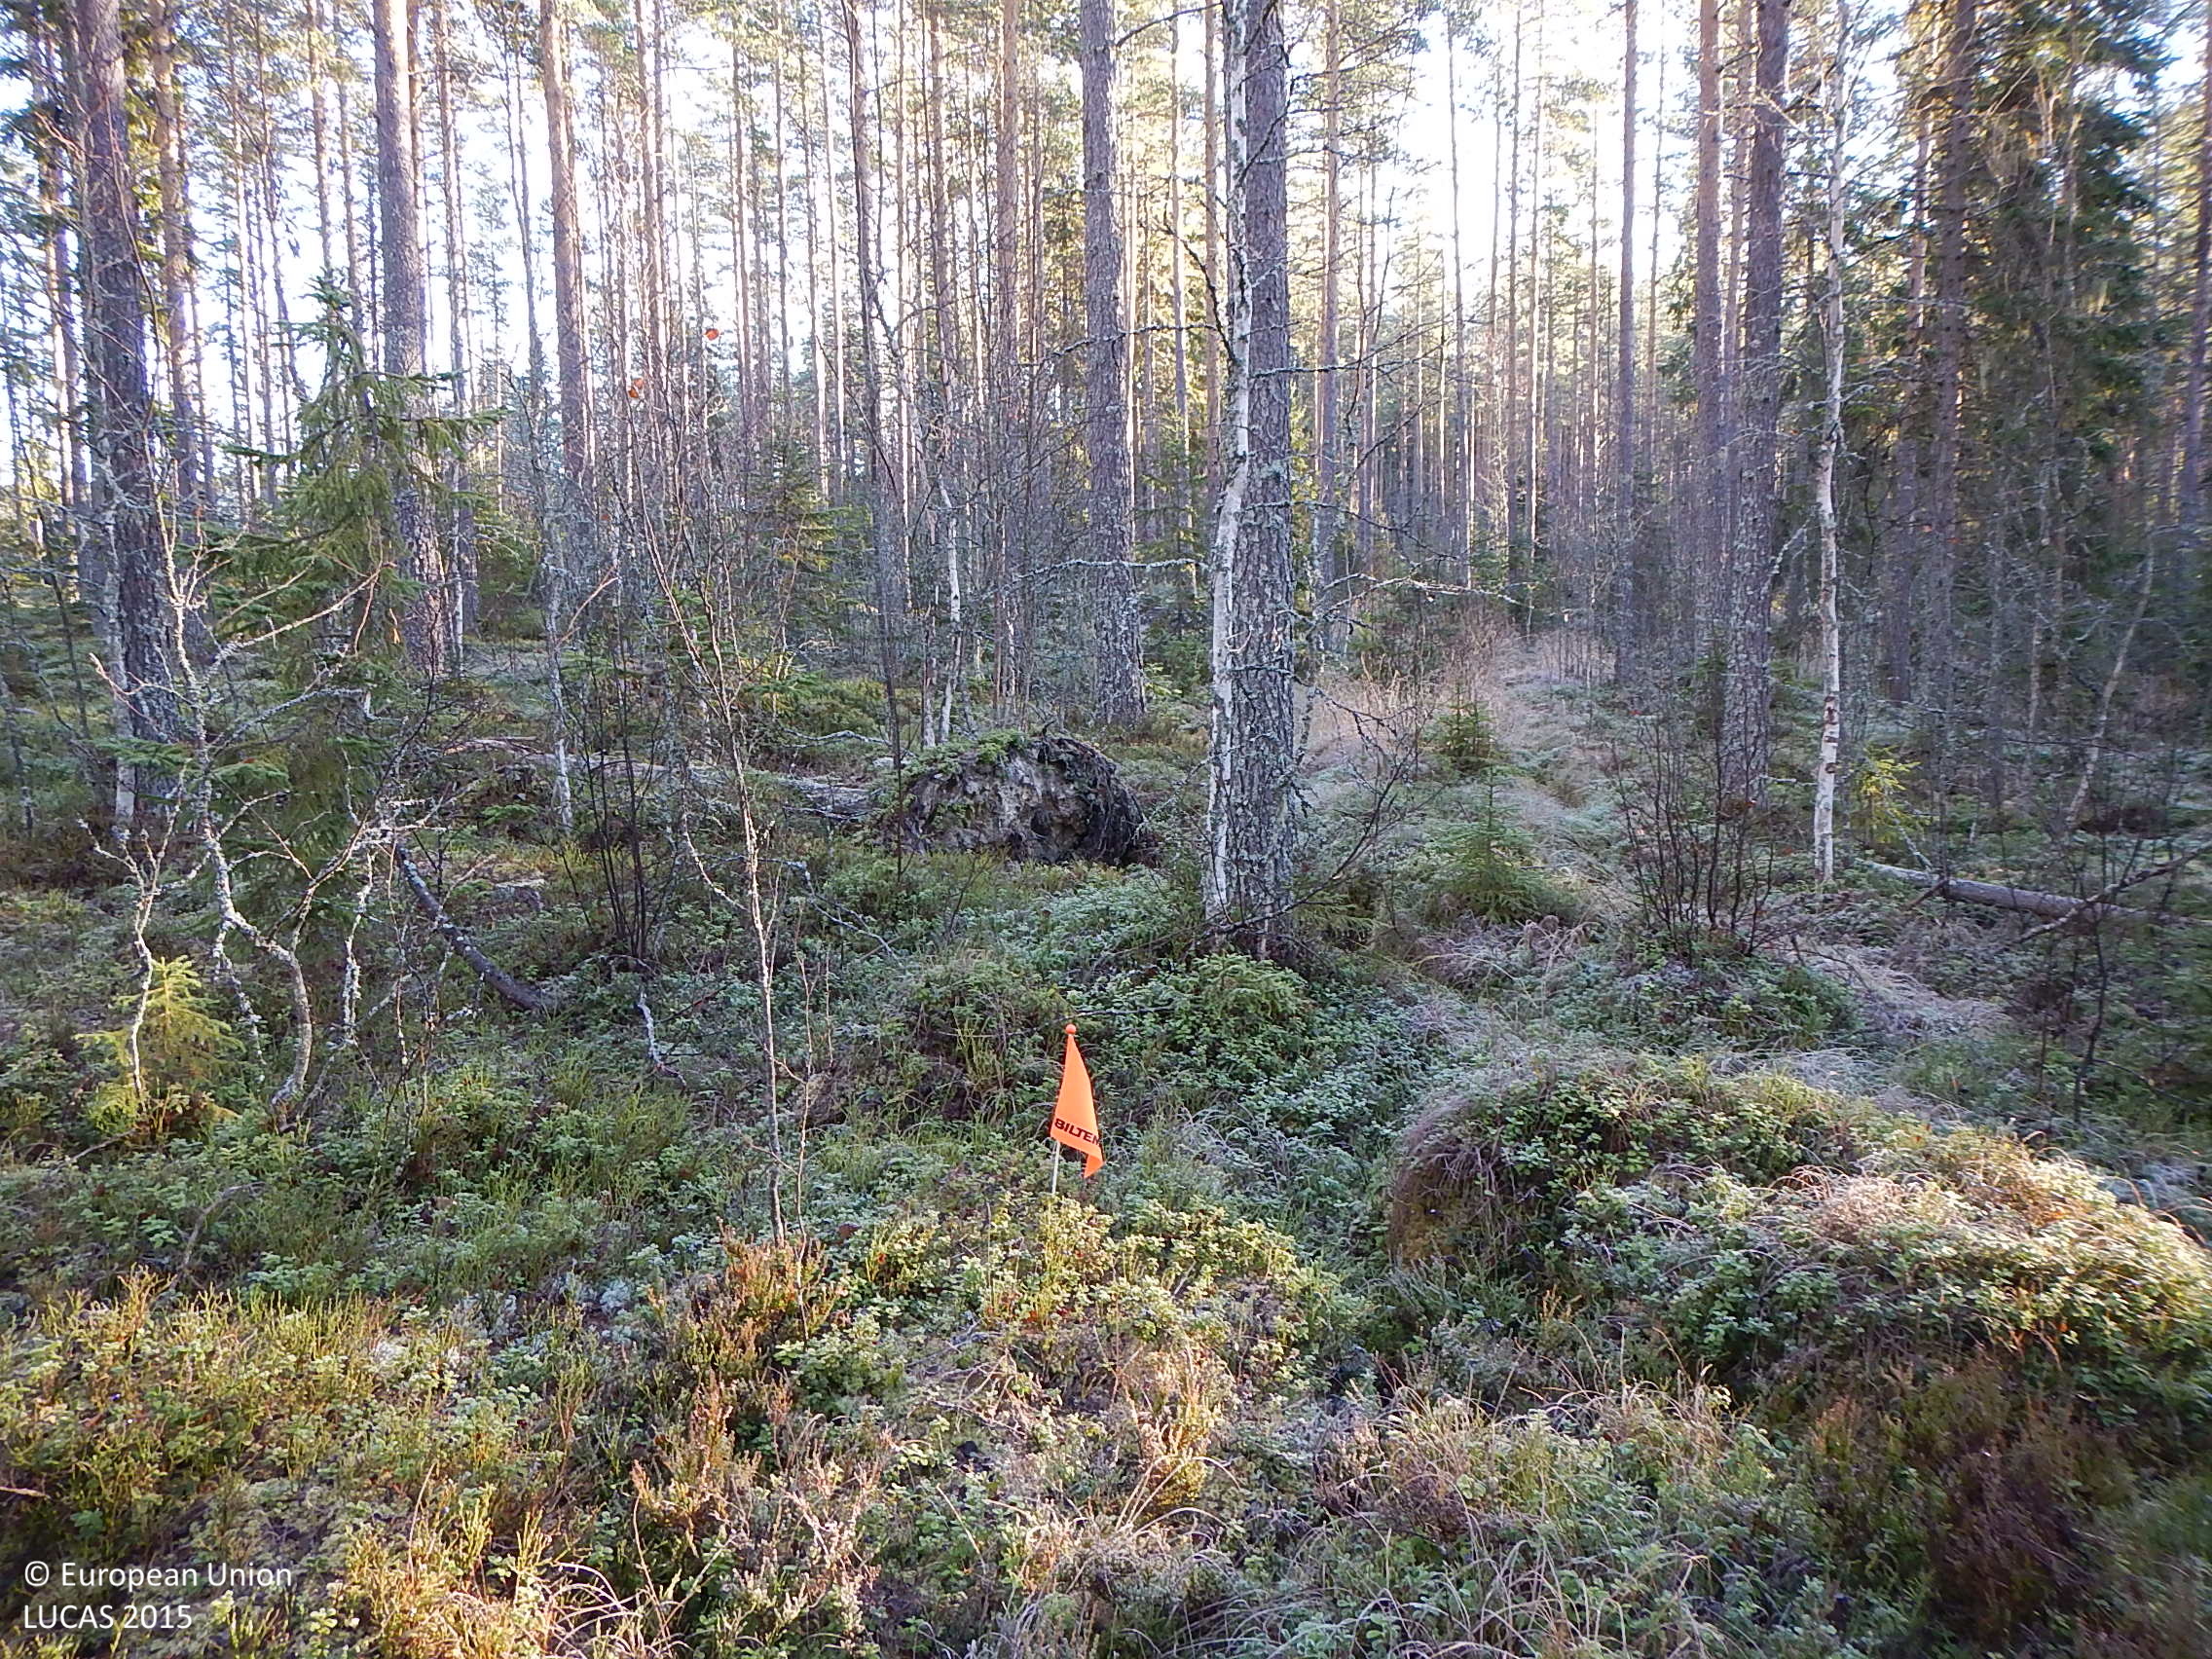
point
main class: Woodland
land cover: Pine dominated coniferous woodland
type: mire and swamp forests
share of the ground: 50 - 75 %
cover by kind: coniferous forest trees 60 %, shrubs 25 %, lichens and mosses 10 %, broadleaved forest trees 5 %
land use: Forestry
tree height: > 5 m
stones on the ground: < 10 %
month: November
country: SE
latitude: 61.5726
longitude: 15.9528
